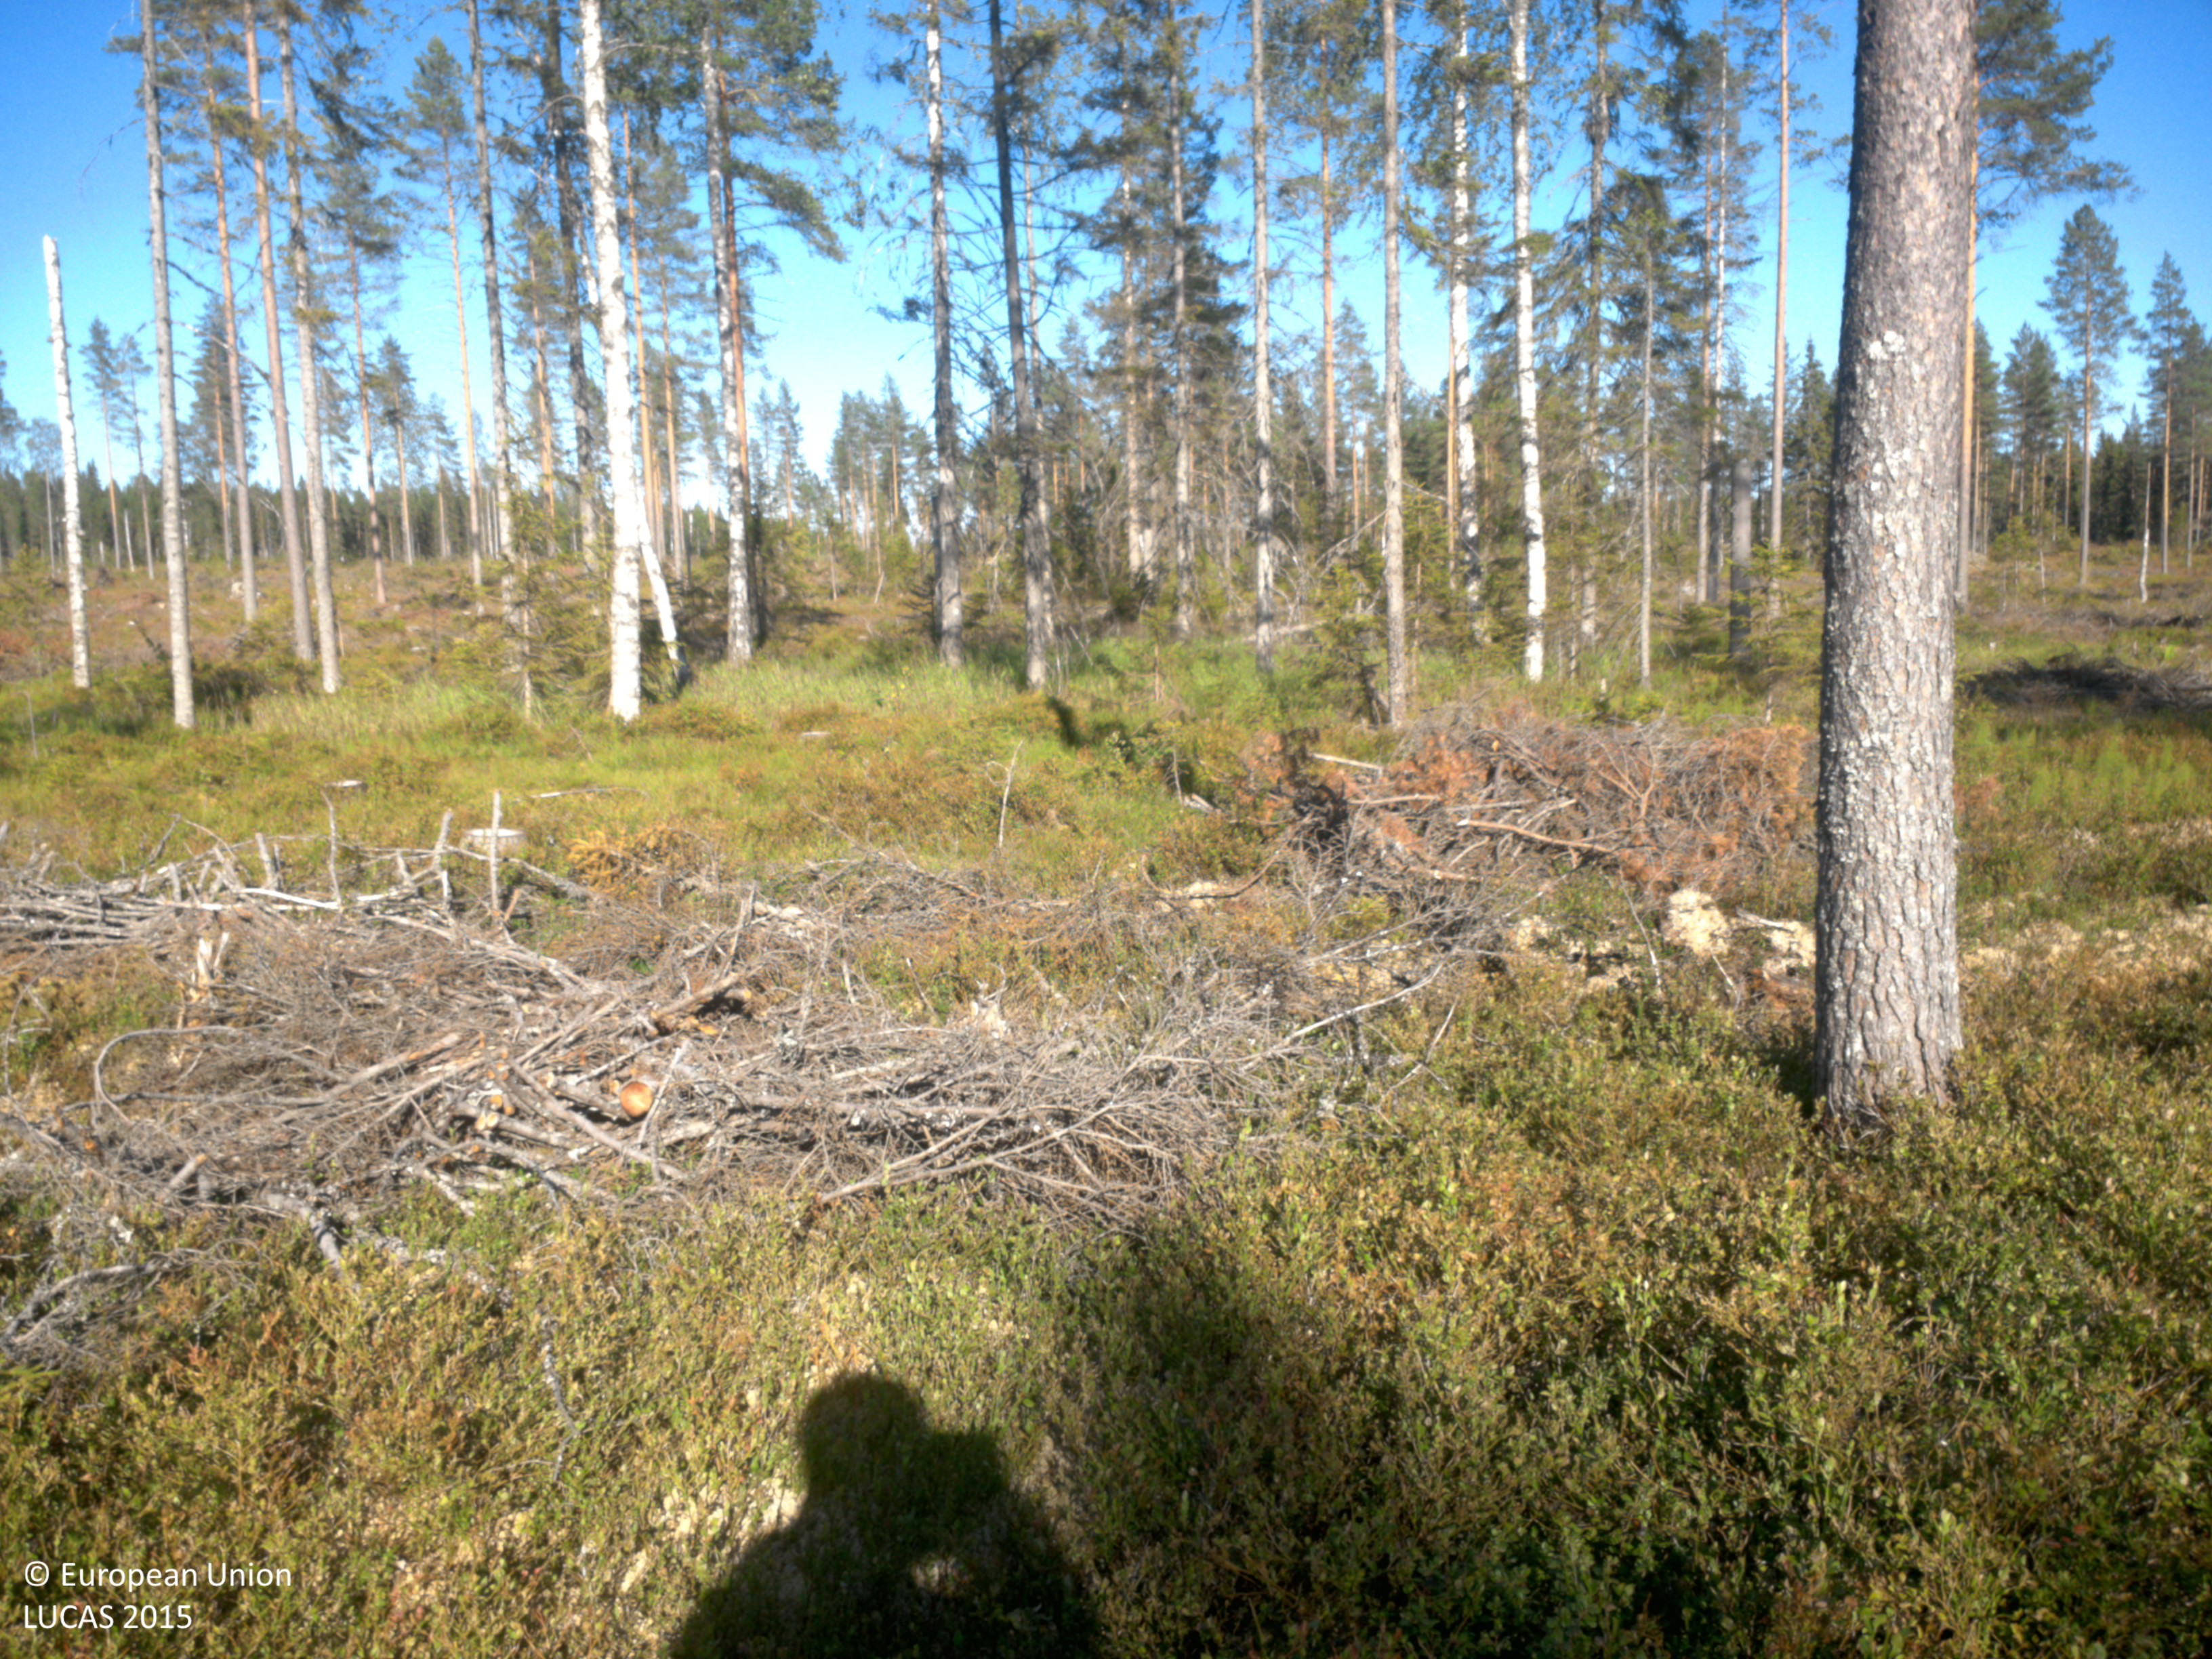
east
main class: Woodland
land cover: Pine dominated coniferous woodland
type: boreal forest
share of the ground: 10 - 25 %
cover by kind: shrubs 45 %, lichens and mosses 40 %, coniferous forest trees 15 %
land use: Forestry
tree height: > 5 m
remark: Clear cut
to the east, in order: Pine dominated coniferous woodland; Ditches and canals; Spruce dominated mixed woodland; Pine dominated coniferous woodland; Pine dominated mixed woodland; Tracks; Pine dominated coniferous woodland
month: August
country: SE
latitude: 63.6969
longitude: 19.7495
